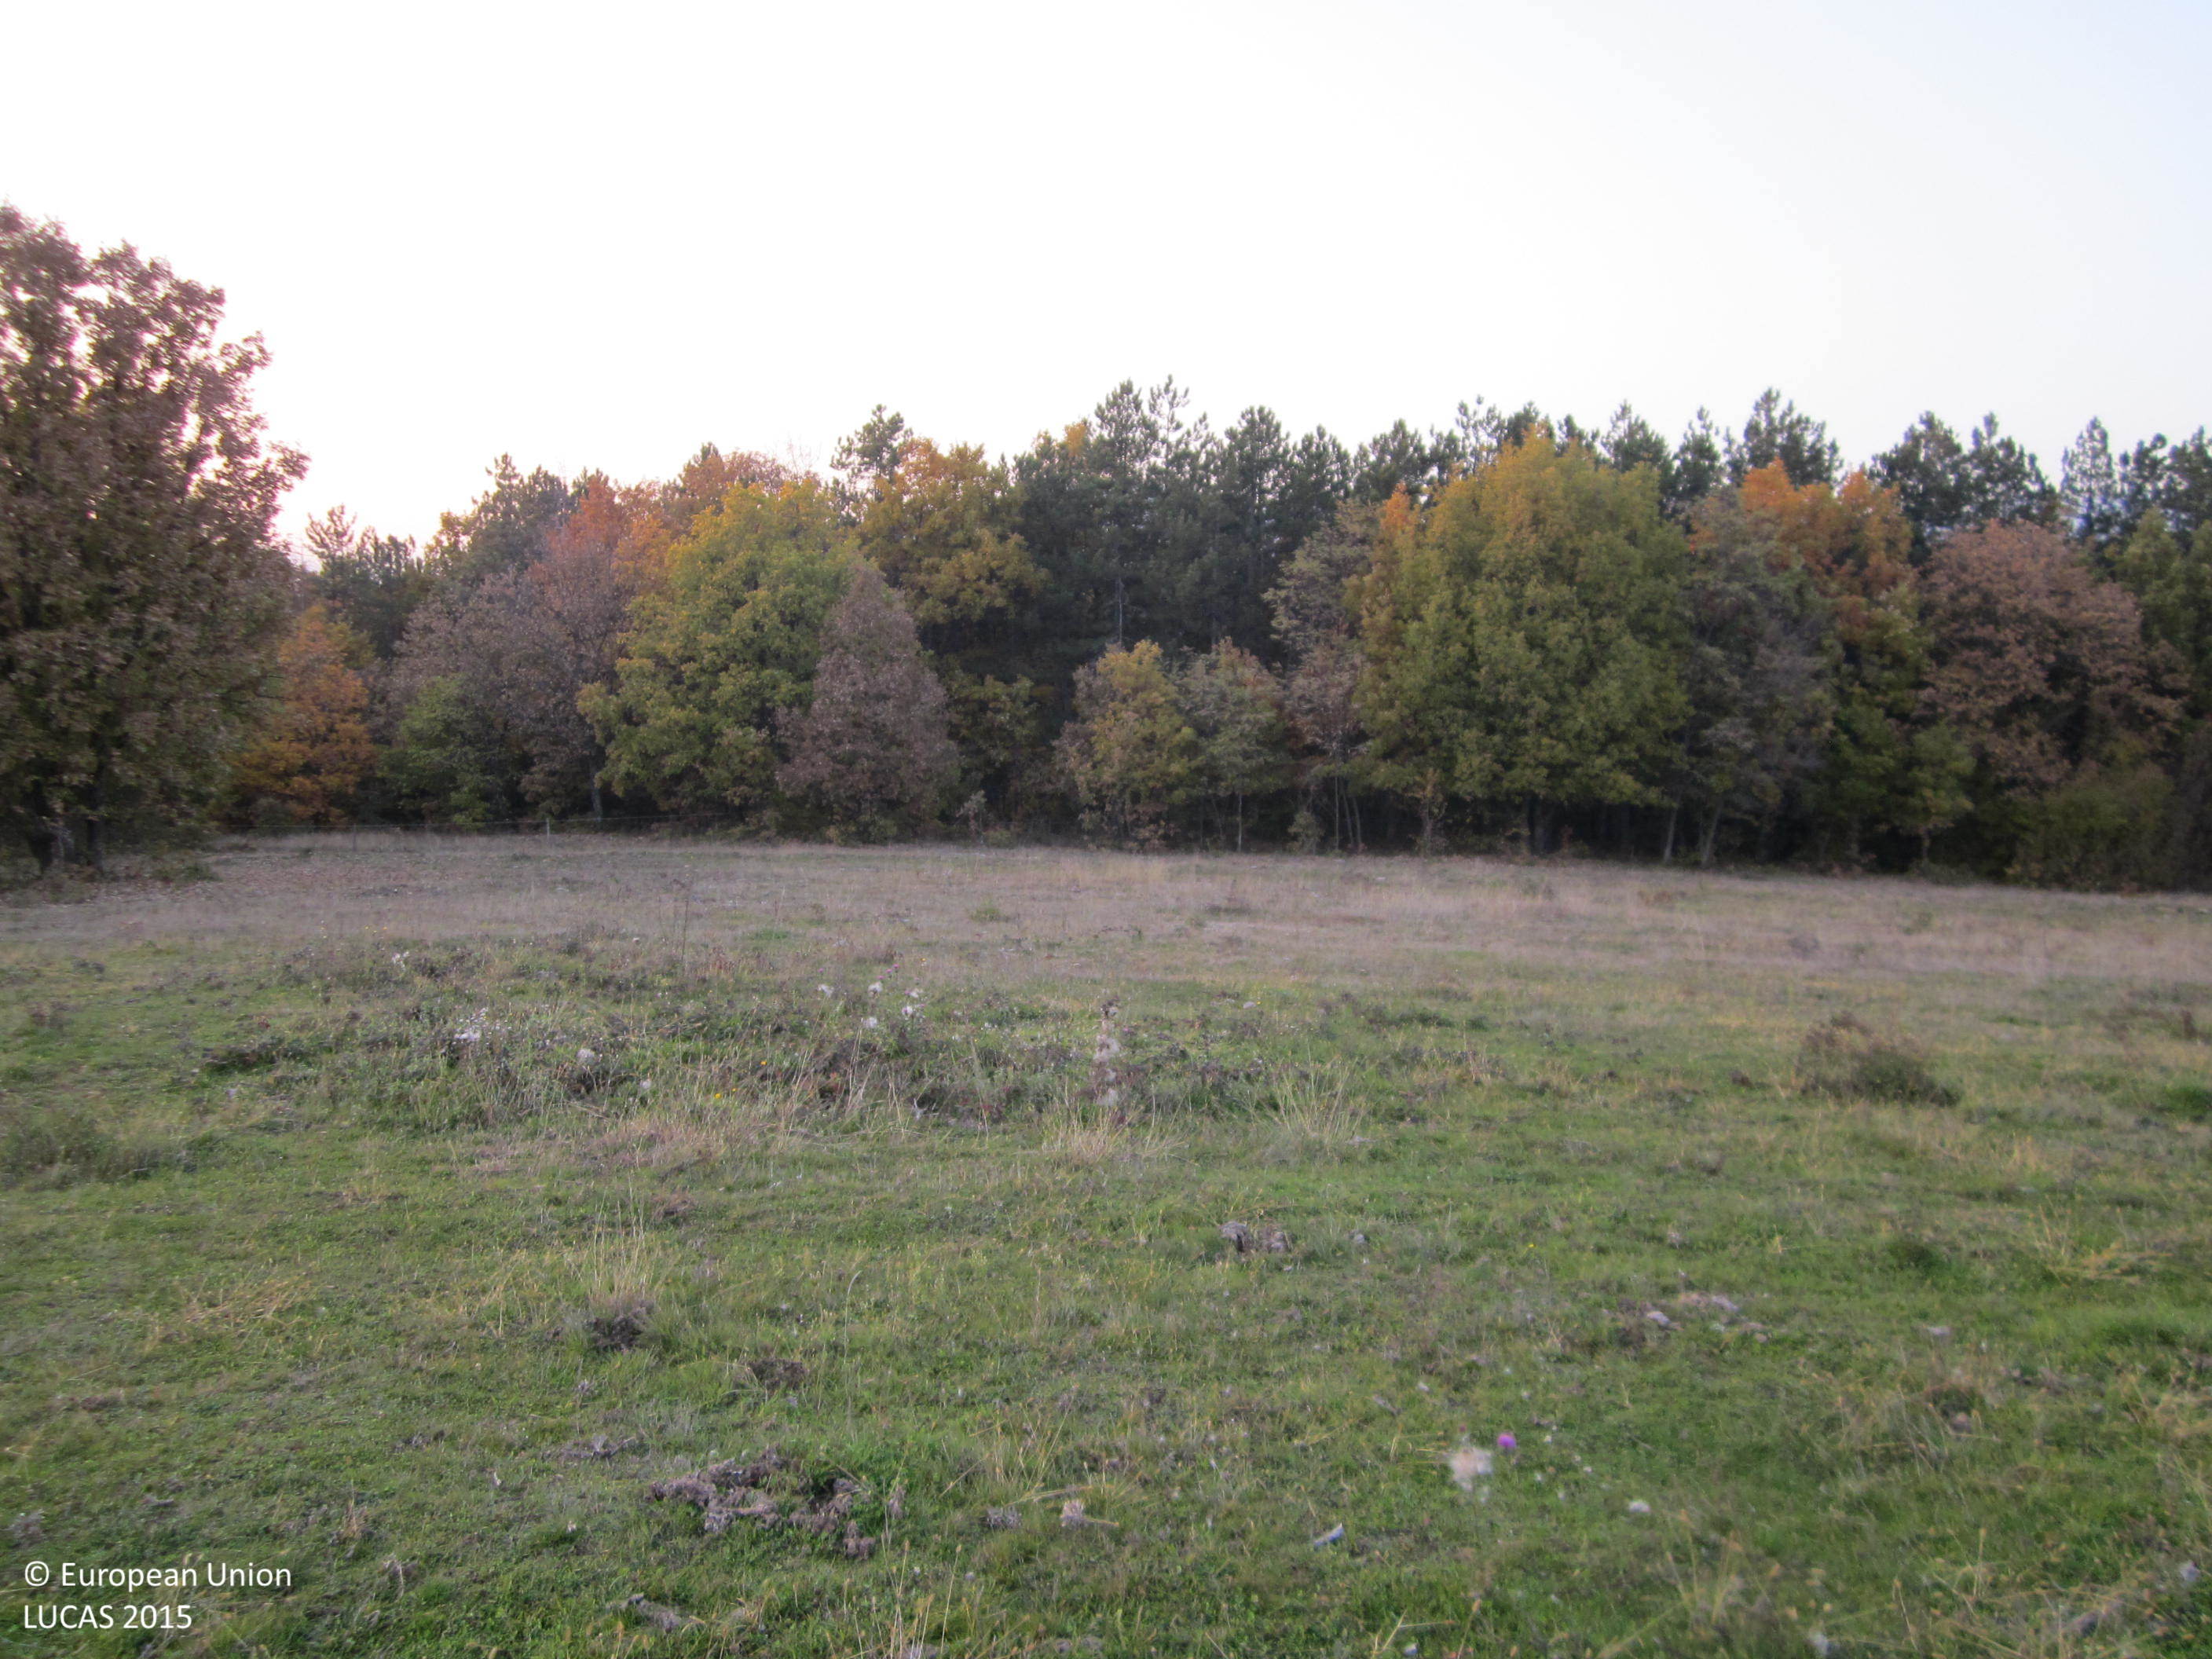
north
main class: Grassland
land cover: Grassland without tree/shrub cover
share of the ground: > 75 %
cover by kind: herbaceous plants 100 %
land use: Agriculture (excluding fallow land and kitchen gardens)
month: November
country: BG
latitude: 42.4993
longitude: 24.6435
